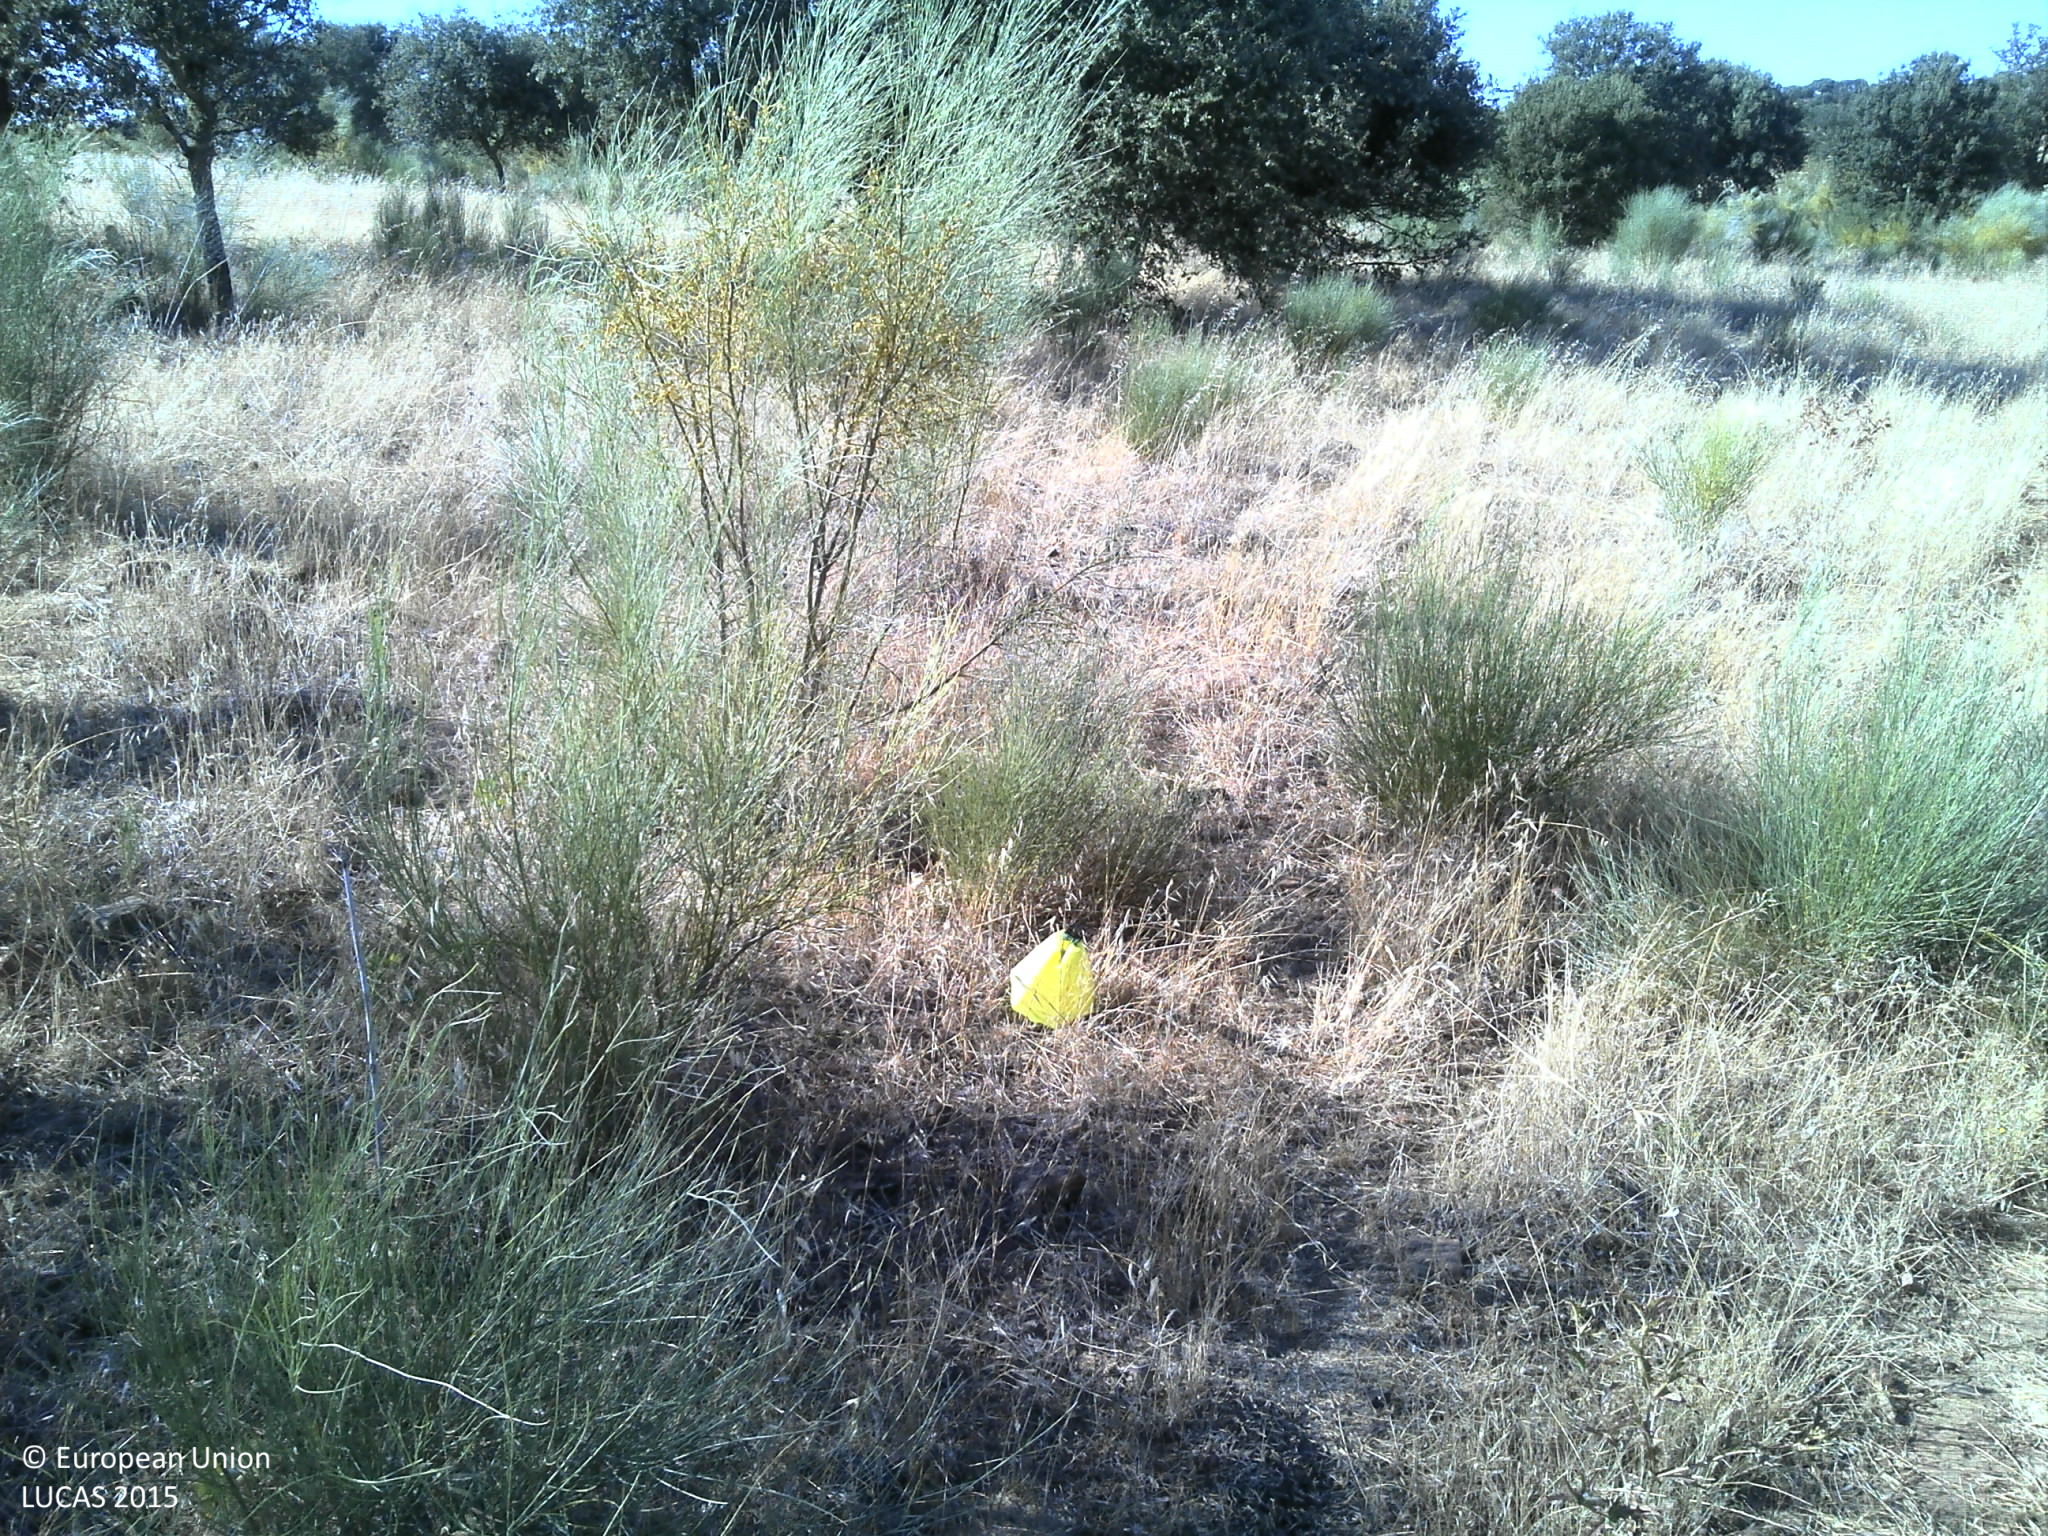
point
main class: Shrubland
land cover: Shrubland with sparse tree cover
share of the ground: 25 - 50 %
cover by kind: unconsolidated bare surface 70 %, shrubs 15 %, herbaceous plants 10 %, broadleaved forest trees 5 %
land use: Agriculture (excluding fallow land and kitchen gardens)
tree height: < 5 m
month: July
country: PT
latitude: 38.9664
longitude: -7.4518
